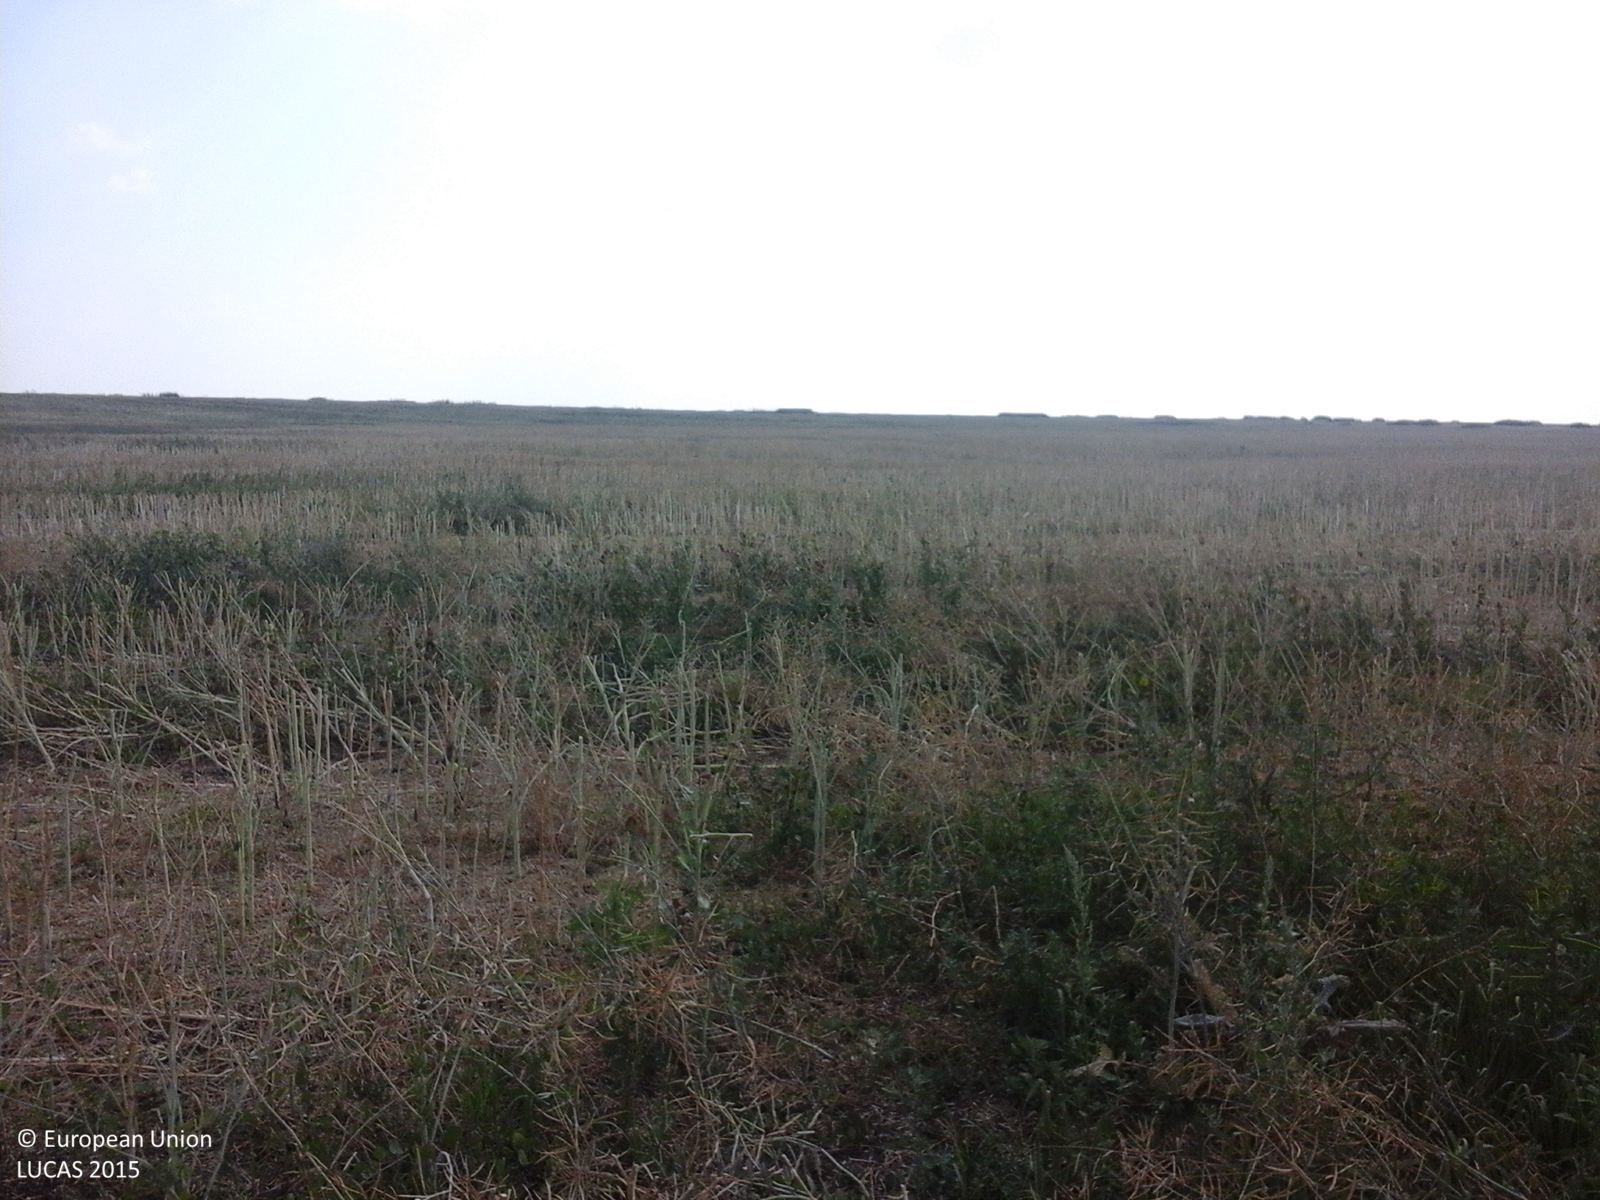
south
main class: Cropland
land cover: Rape and turnip rape
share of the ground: < 10 %
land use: Agriculture (excluding fallow land and kitchen gardens)
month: July
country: RO
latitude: 43.8801
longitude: 24.8452
